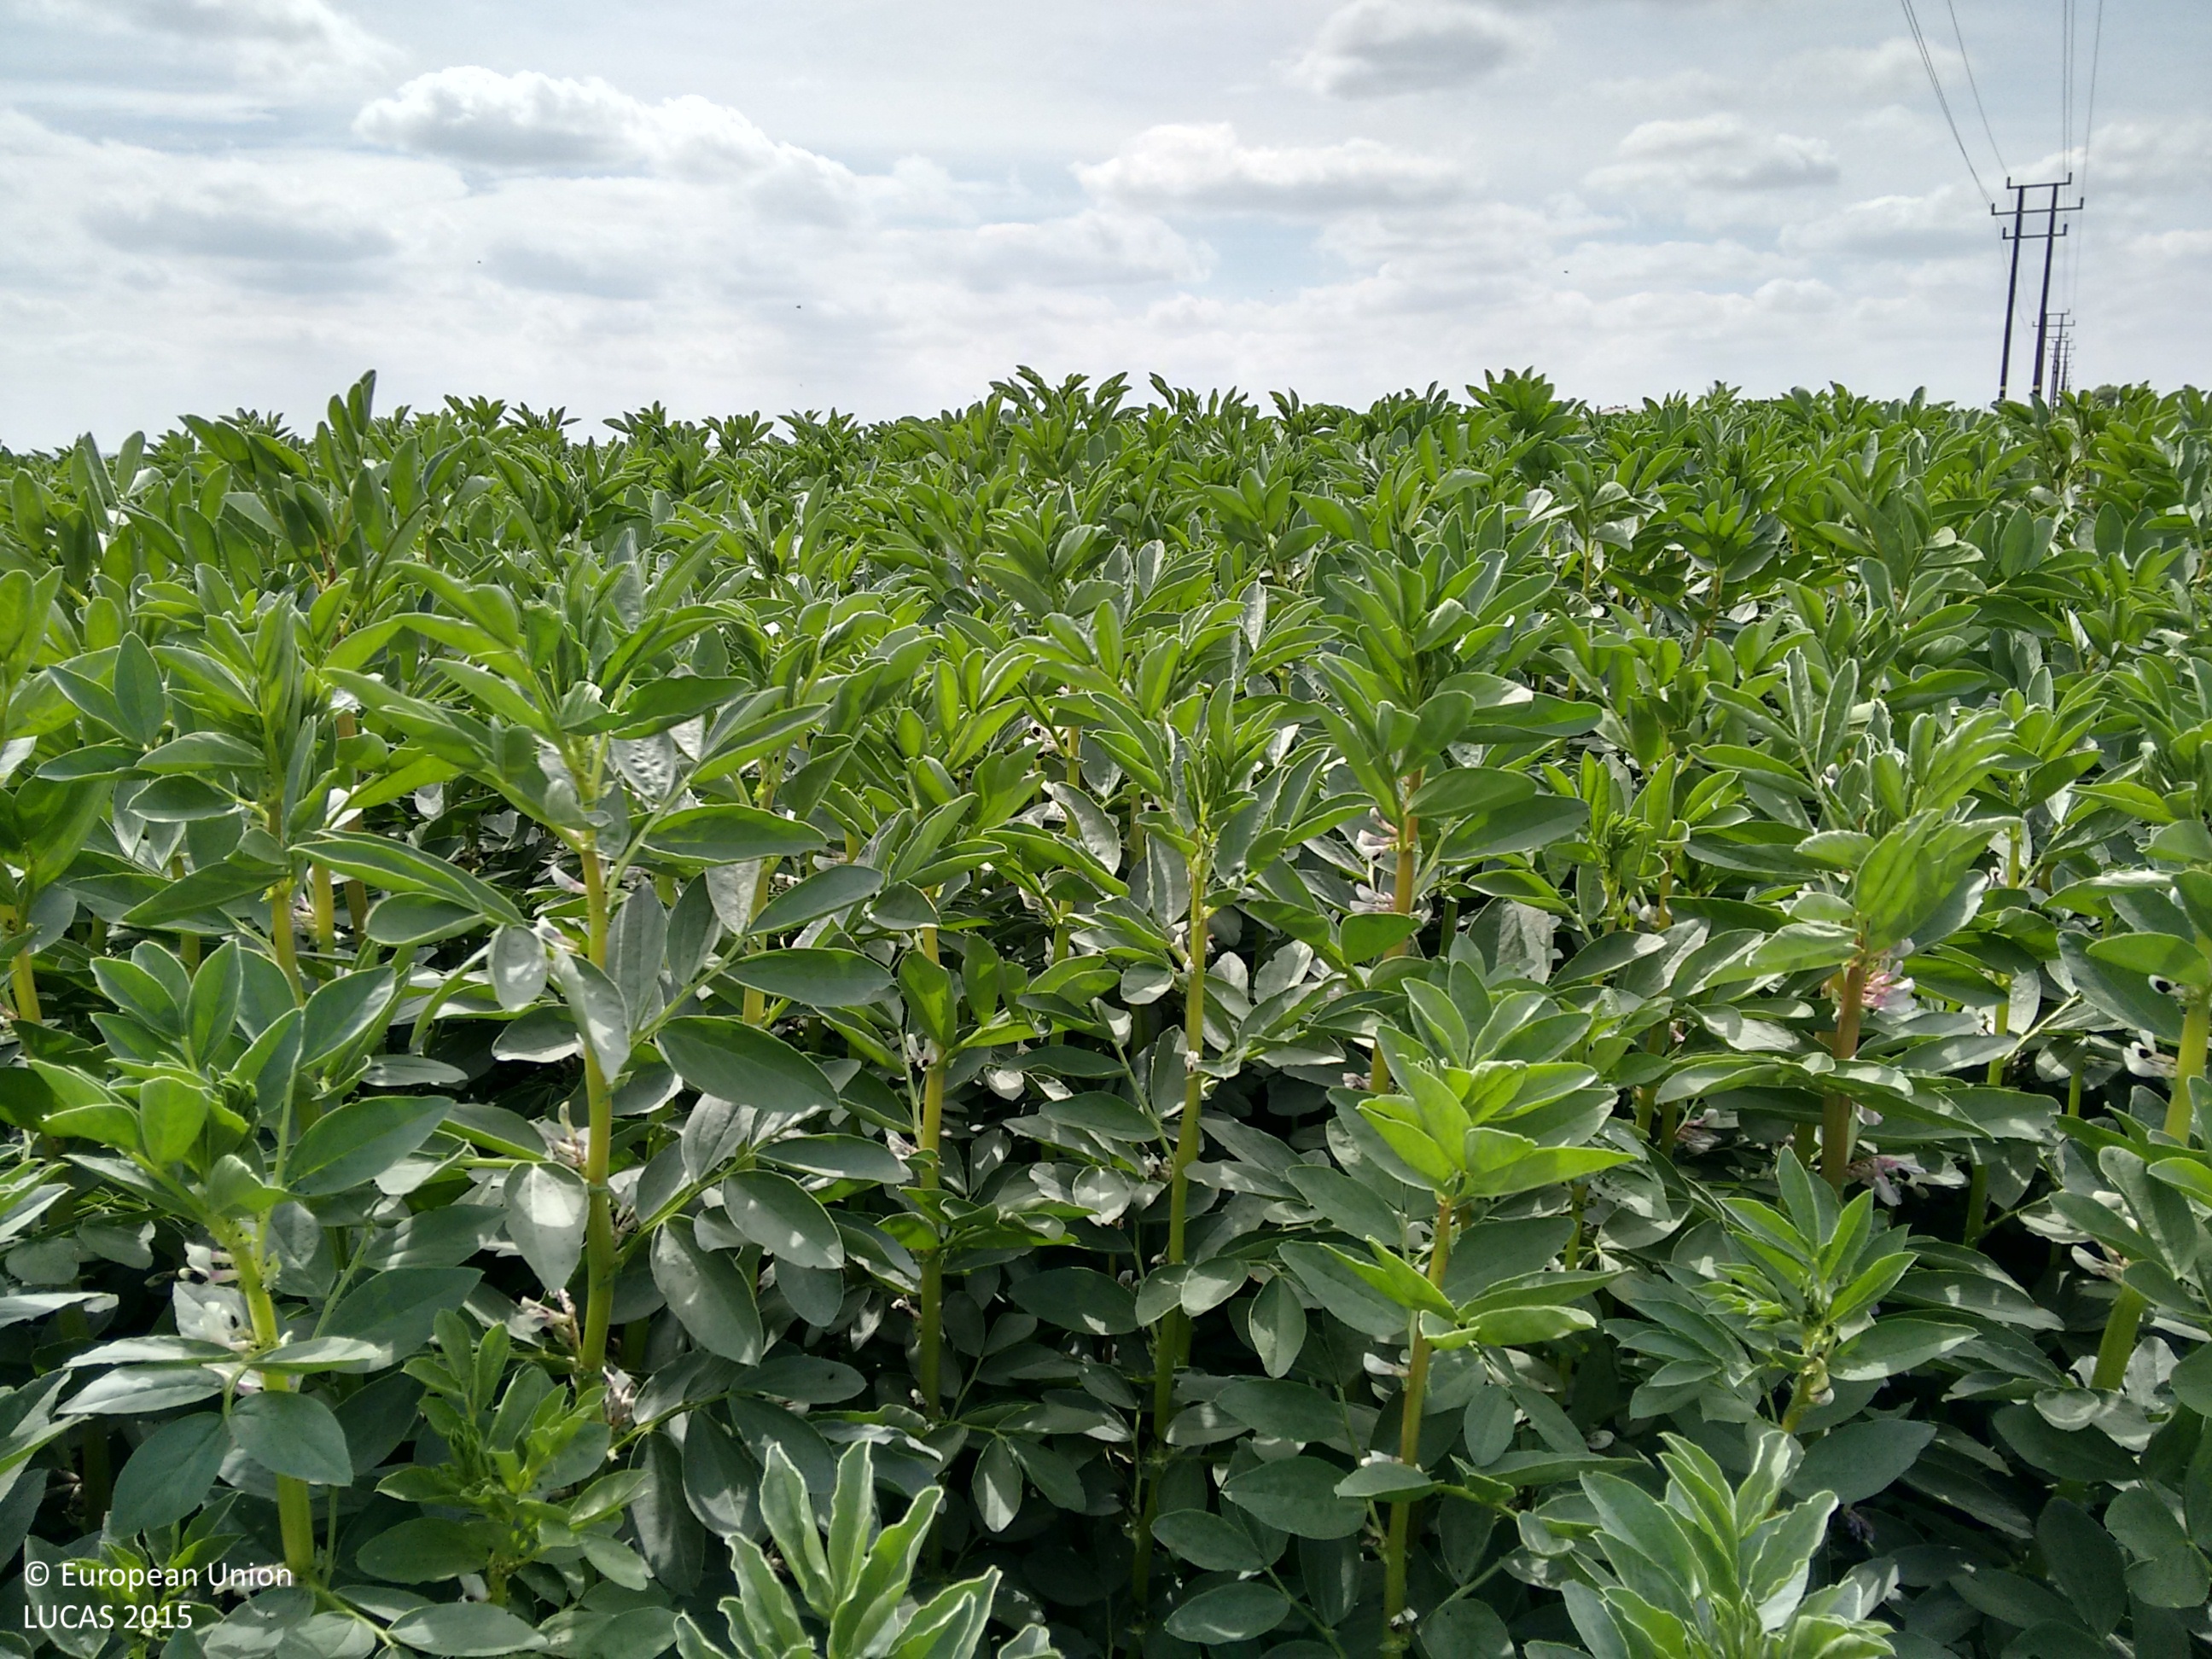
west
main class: Cropland
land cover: Dry pulses
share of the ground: > 75 %
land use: Agriculture (excluding fallow land and kitchen gardens)
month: June
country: GB
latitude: 52.9959
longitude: -0.9343
